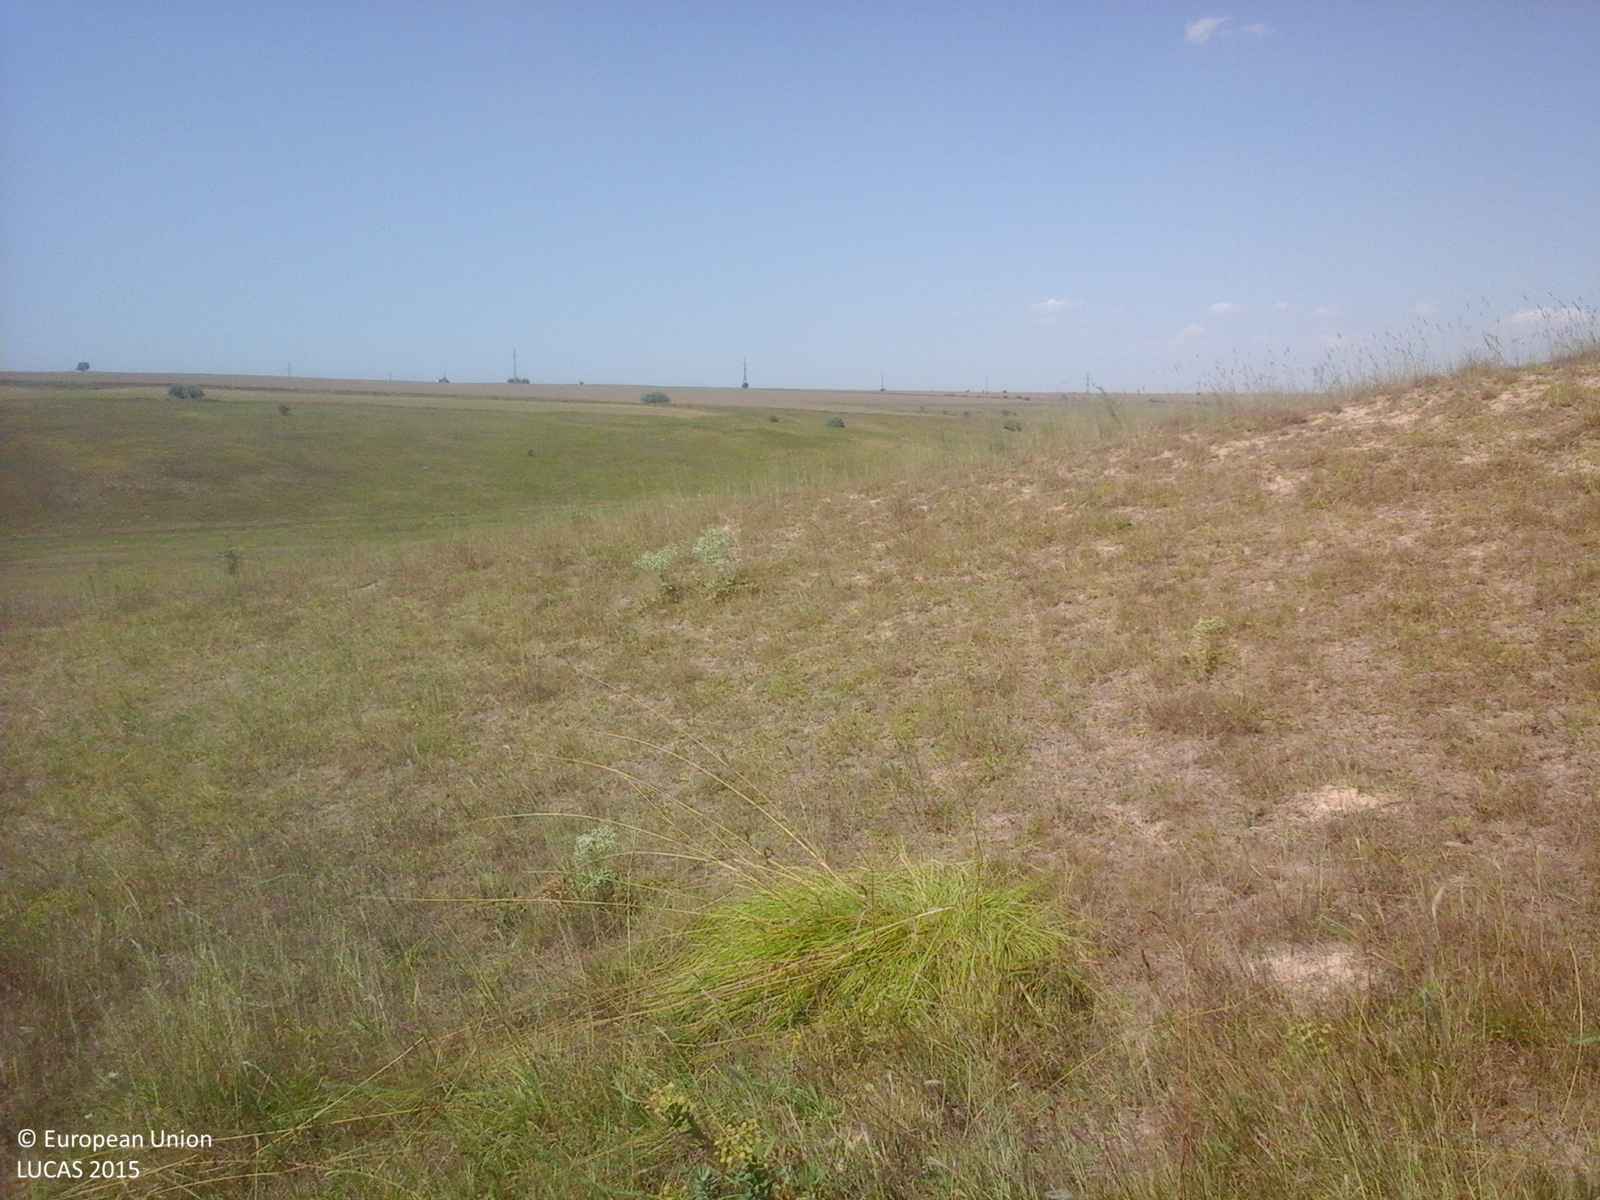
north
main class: Grassland
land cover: Grassland without tree/shrub cover
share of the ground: > 75 %
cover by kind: herbaceous plants 100 %
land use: Agriculture (excluding fallow land and kitchen gardens)
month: August
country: RO
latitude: 44.4939
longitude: 28.1066
